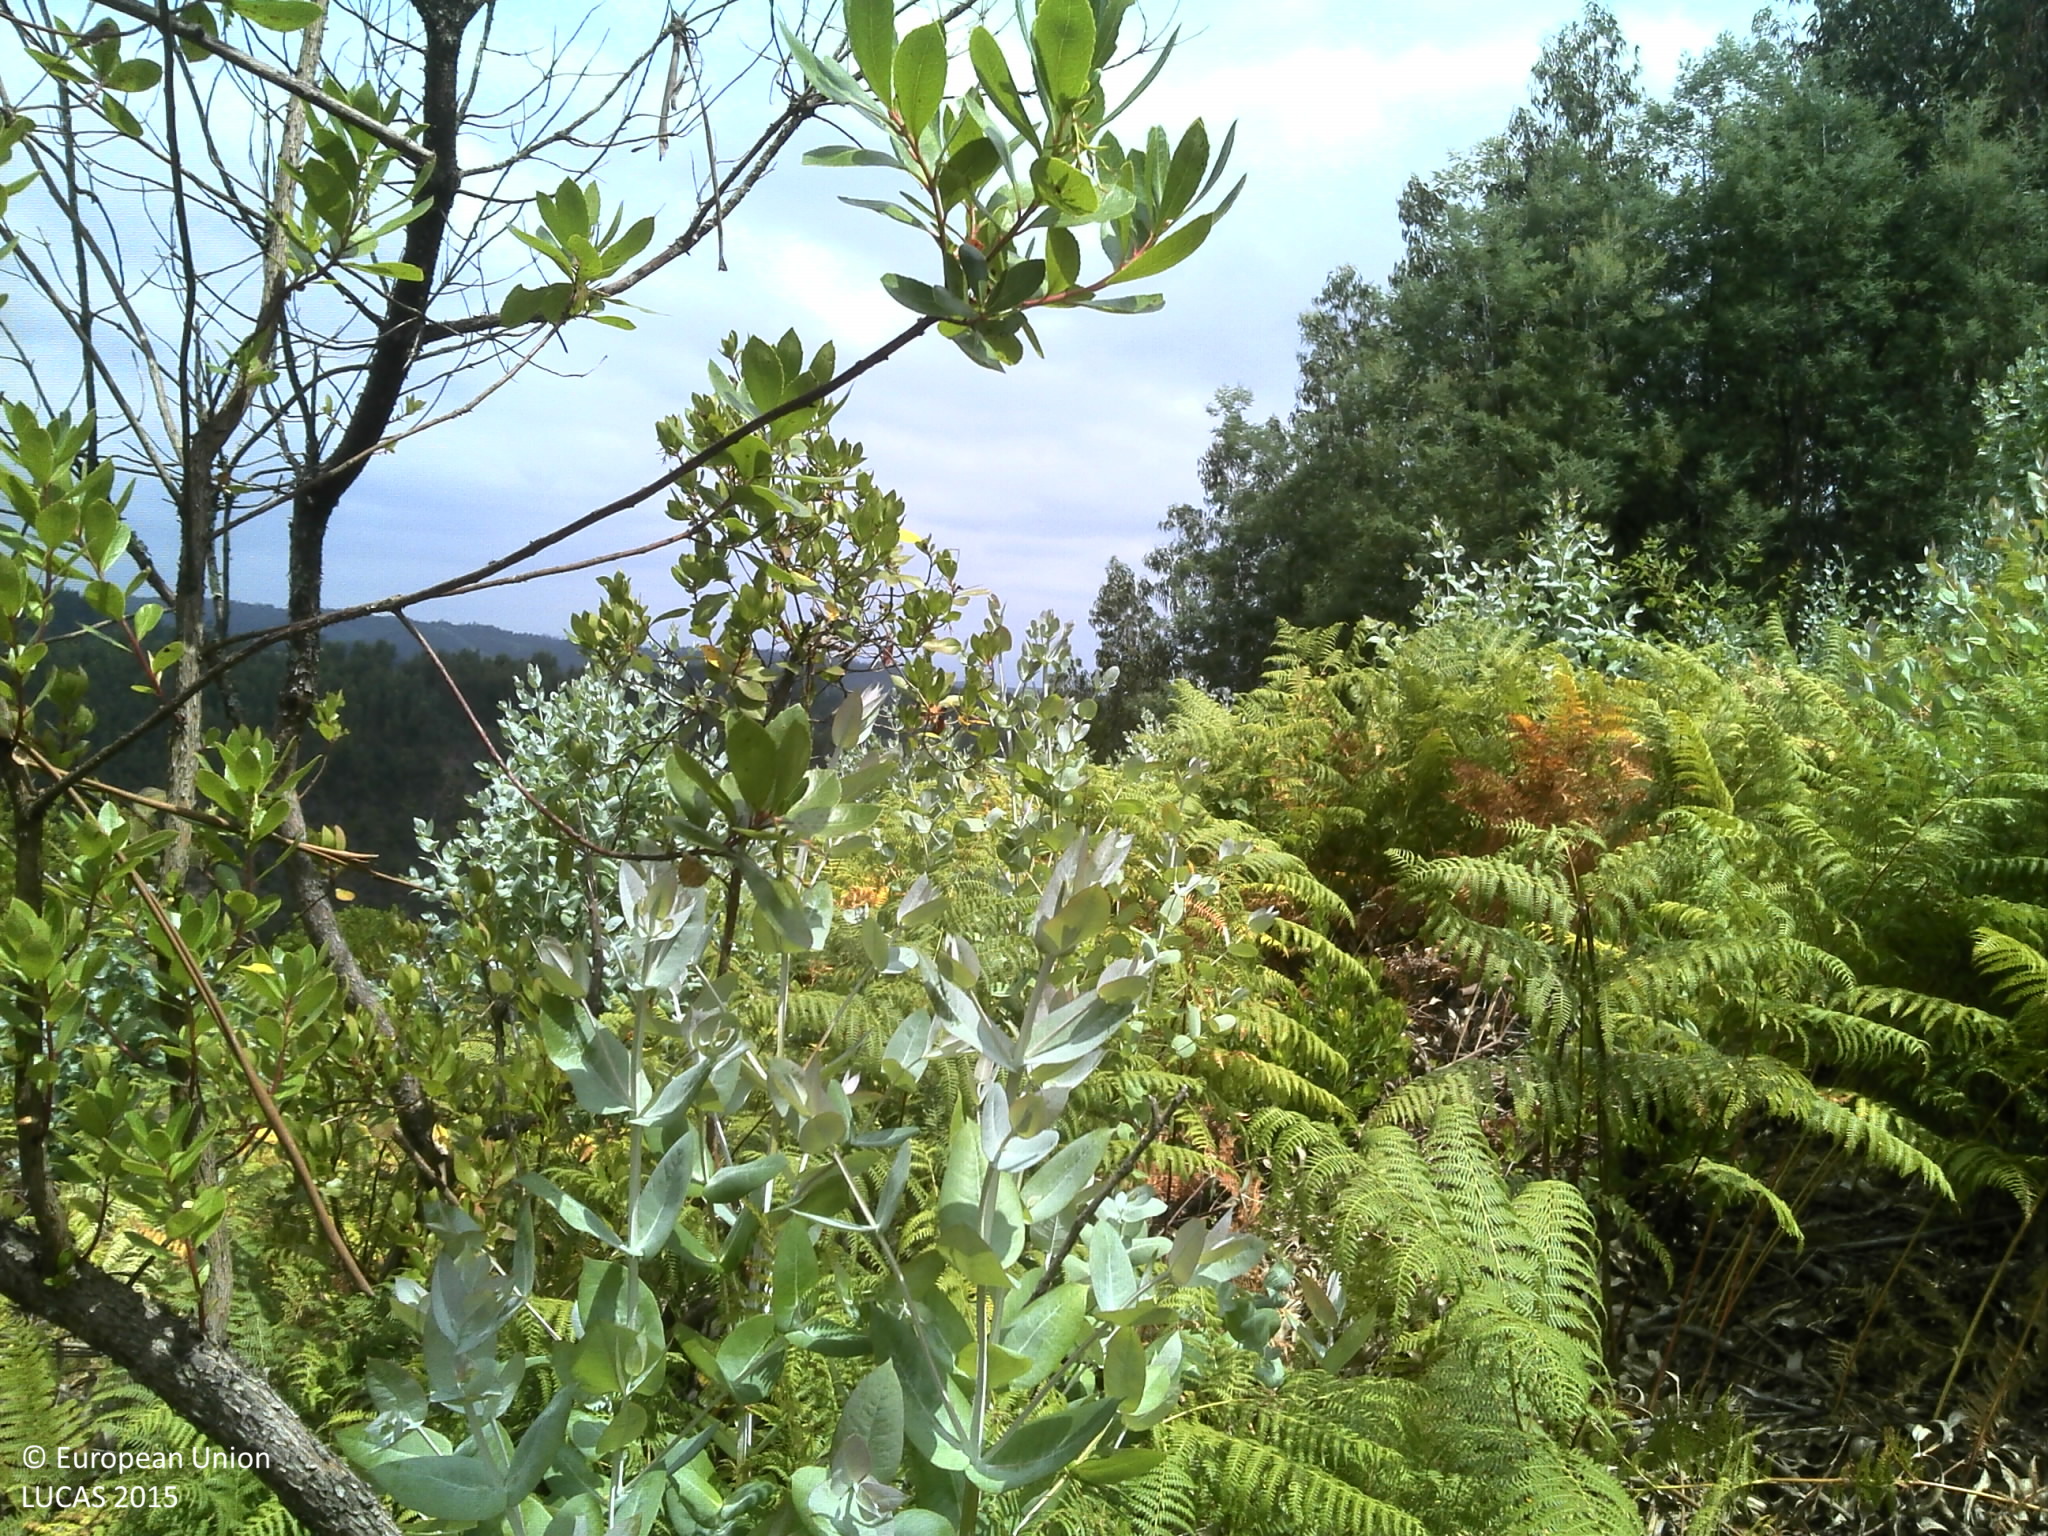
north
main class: Woodland
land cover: Broadleaved woodland
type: exotic forest
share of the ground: < 10 %
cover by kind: unconsolidated bare surface 65 %, shrubs 20 %, broadleaved forest trees 10 %, consolidated bare surface 5 %
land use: Forestry
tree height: > 5 m
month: July
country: PT
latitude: 40.2988
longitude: -8.2326
